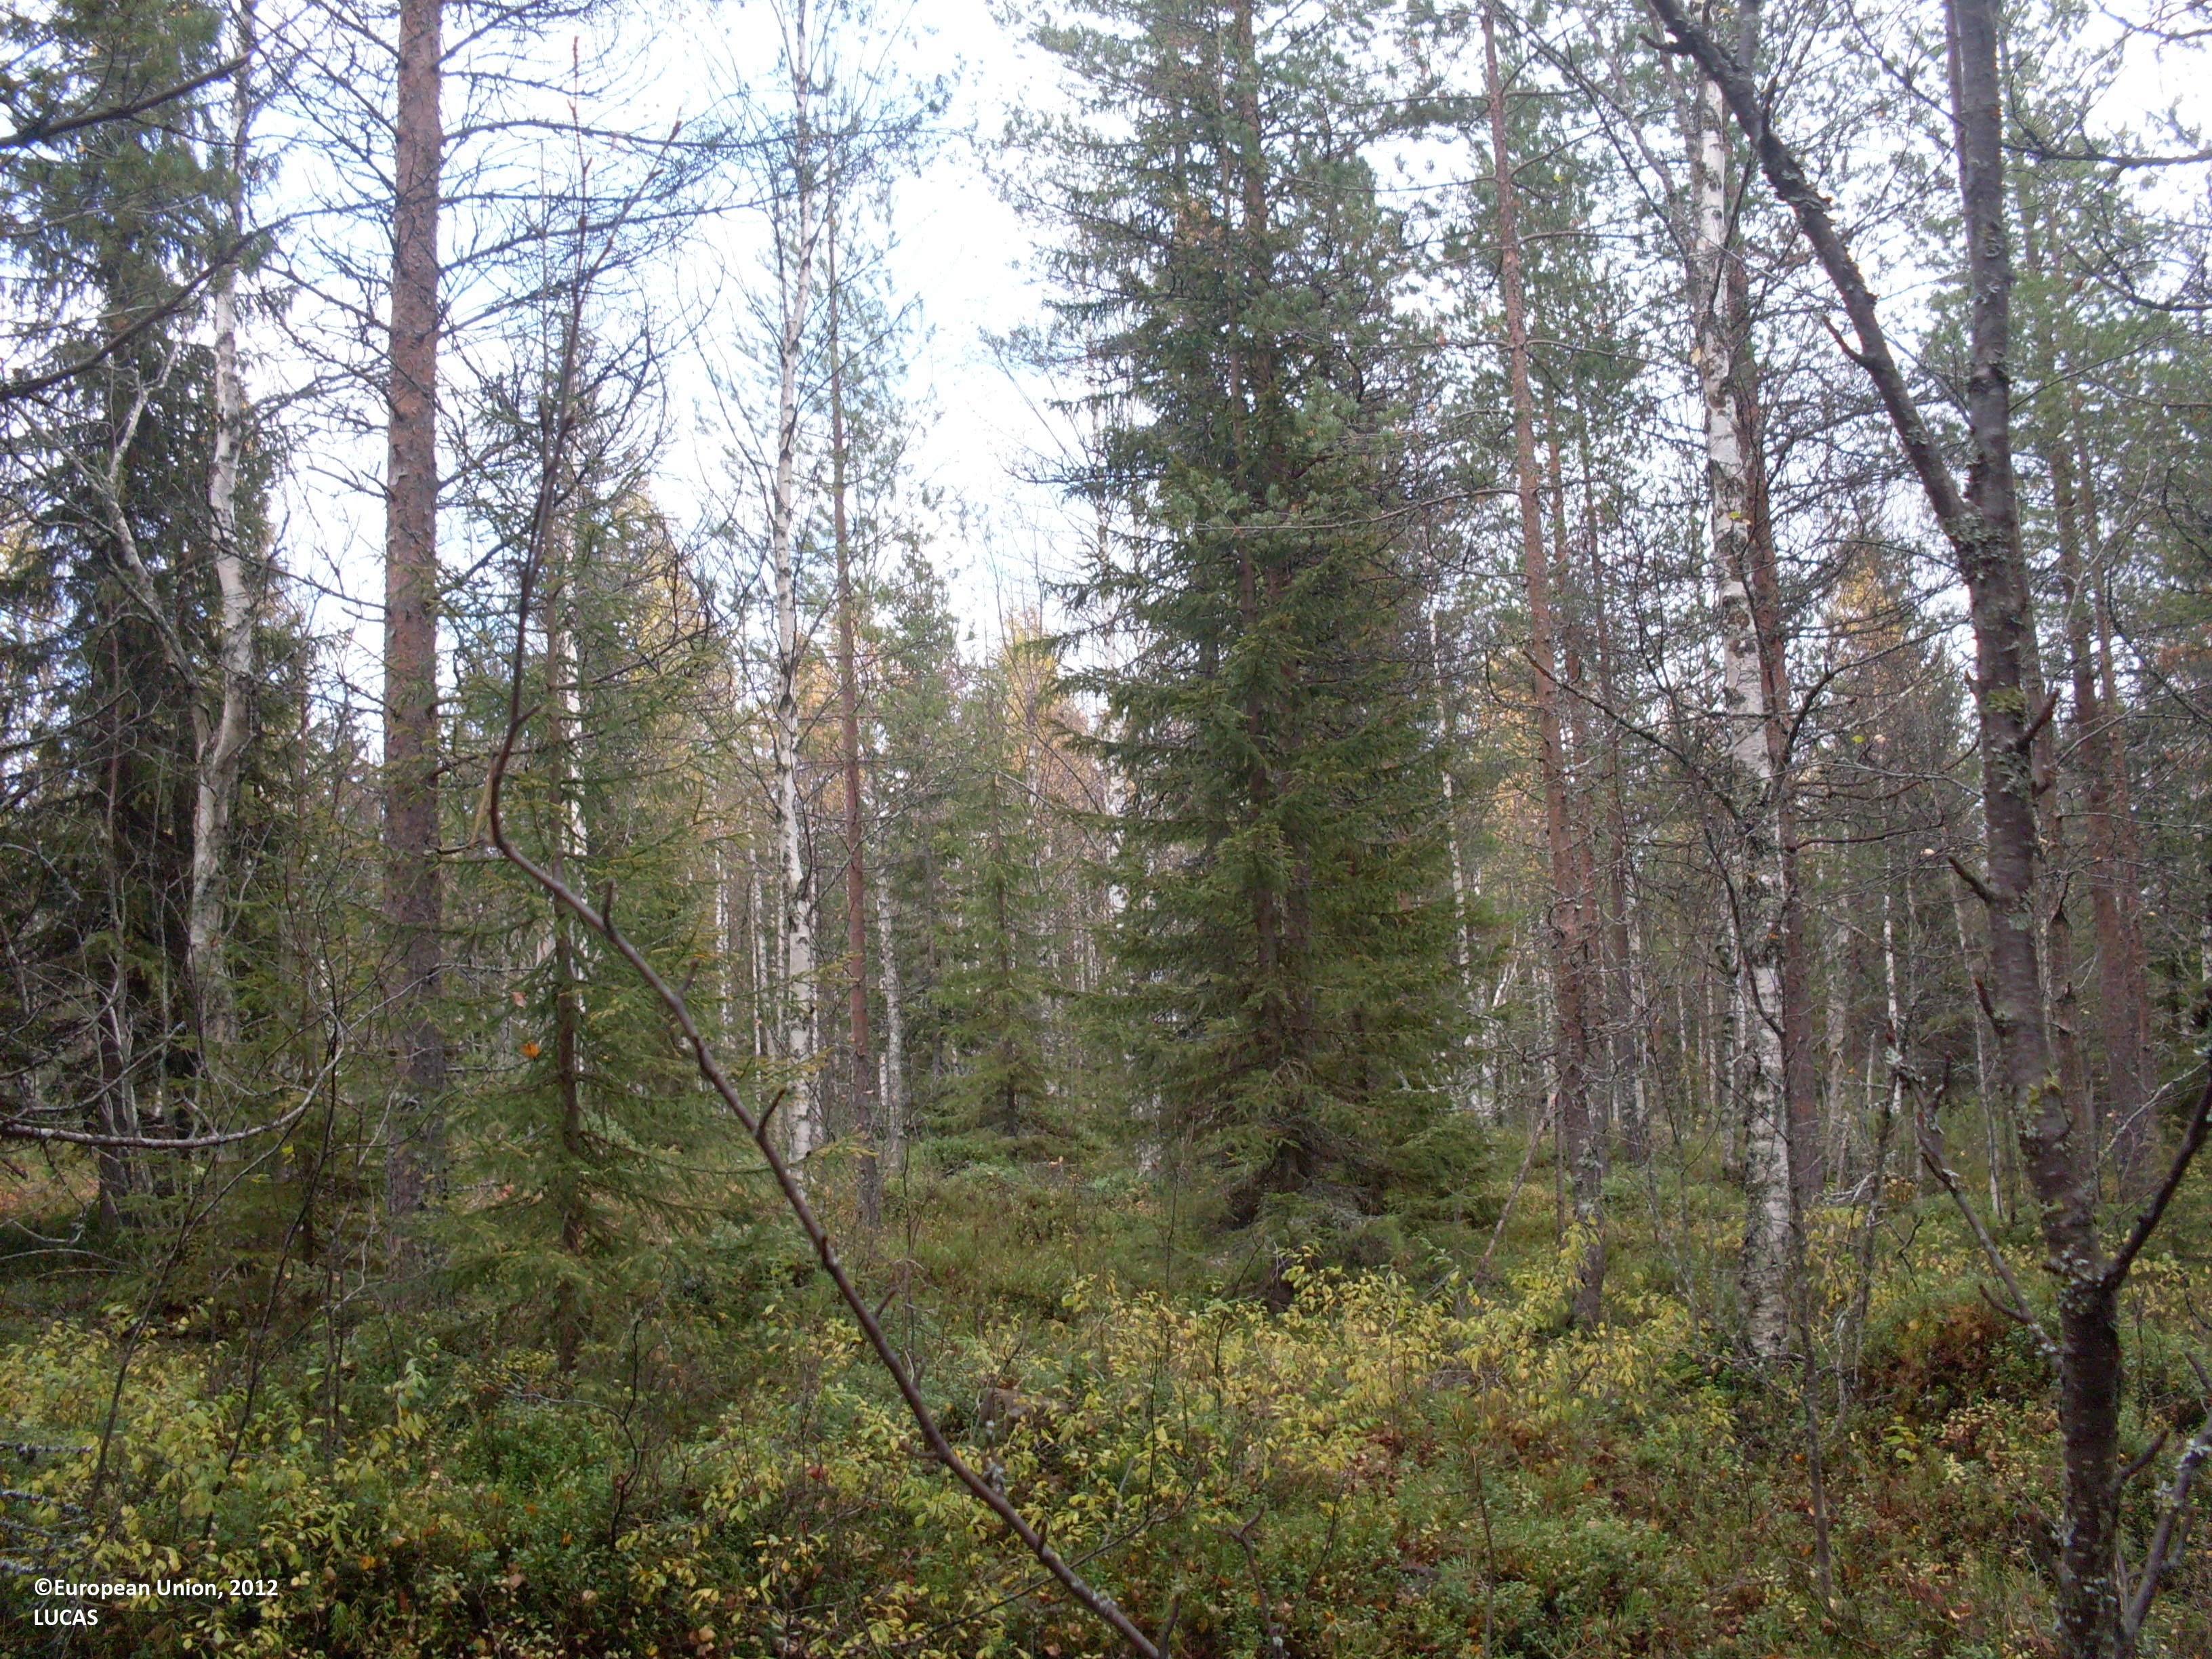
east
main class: Woodland
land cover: Pine dominated mixed woodland
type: boreal forest
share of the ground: 50 - 75 %
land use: Forestry
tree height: > 5 m
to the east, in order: Pine dominated mixed woodland; Ditches and canals; Pine dominated mixed woodland
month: September
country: FI
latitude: 64.8784
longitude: 28.6916
